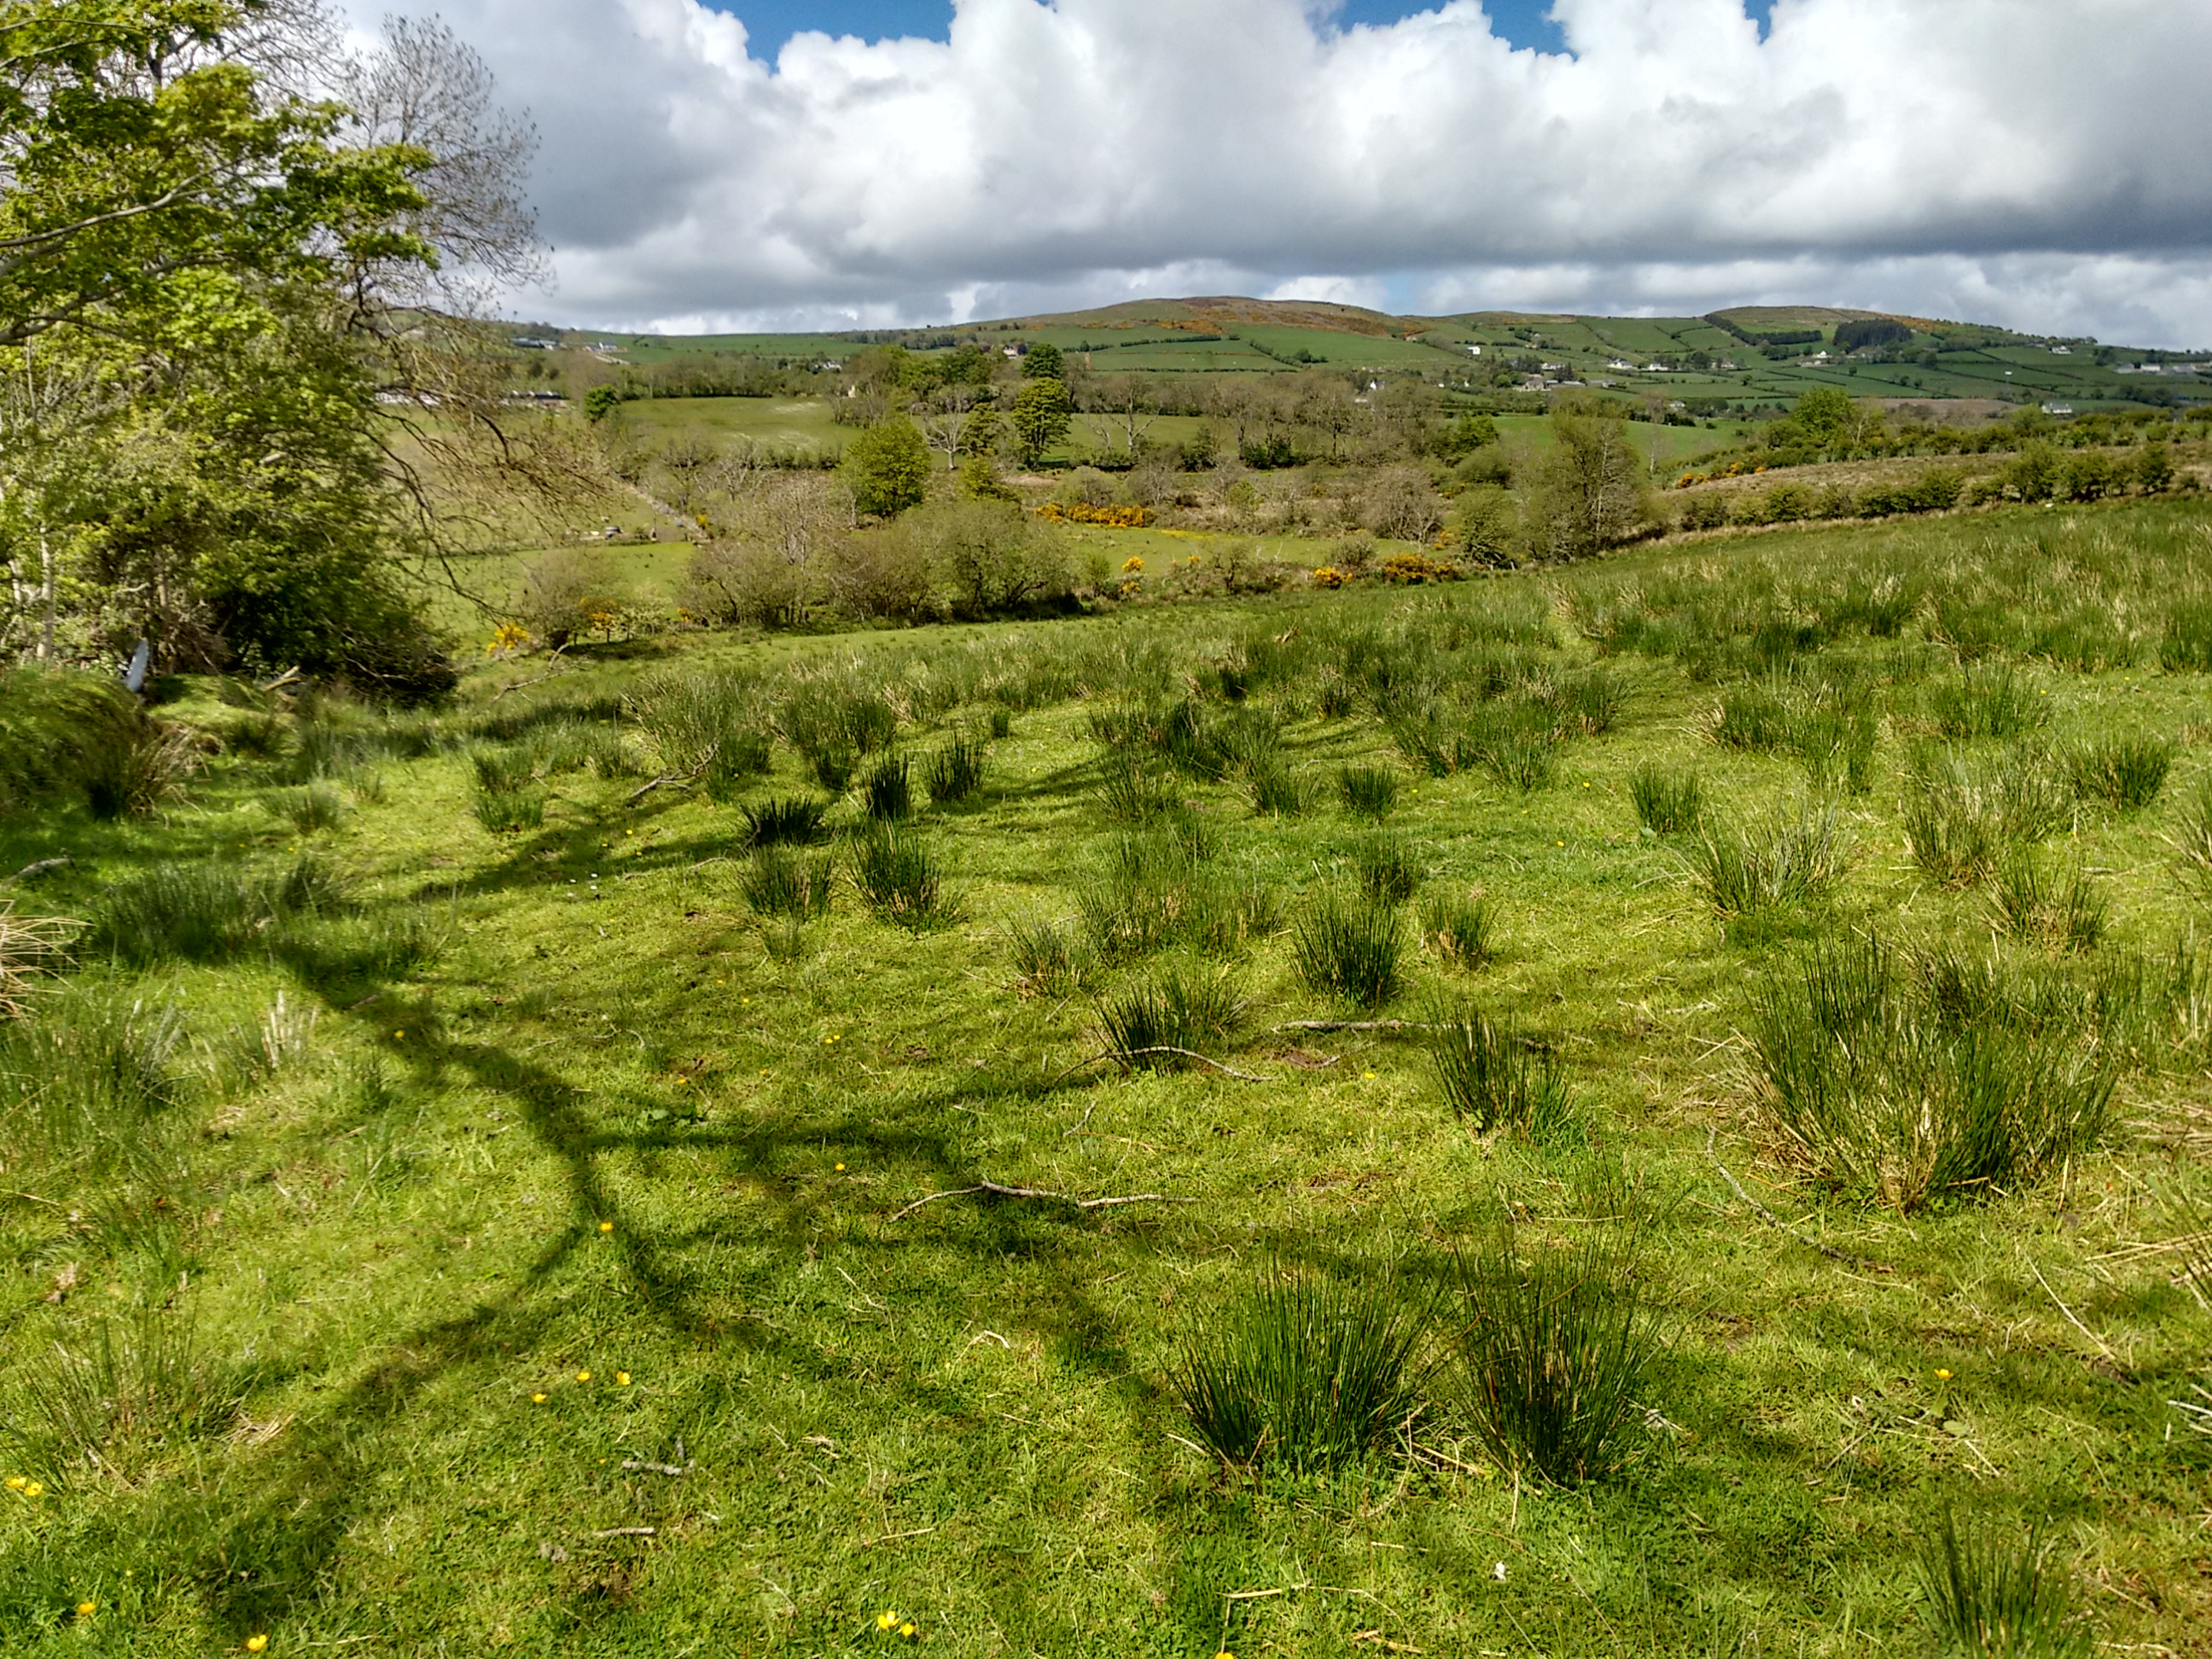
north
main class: Grassland
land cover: Grassland without tree/shrub cover
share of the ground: > 75 %
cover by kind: herbaceous plants 100 %
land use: Agriculture (excluding fallow land and kitchen gardens)
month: May
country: GB
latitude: 54.9119
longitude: -7.1294
